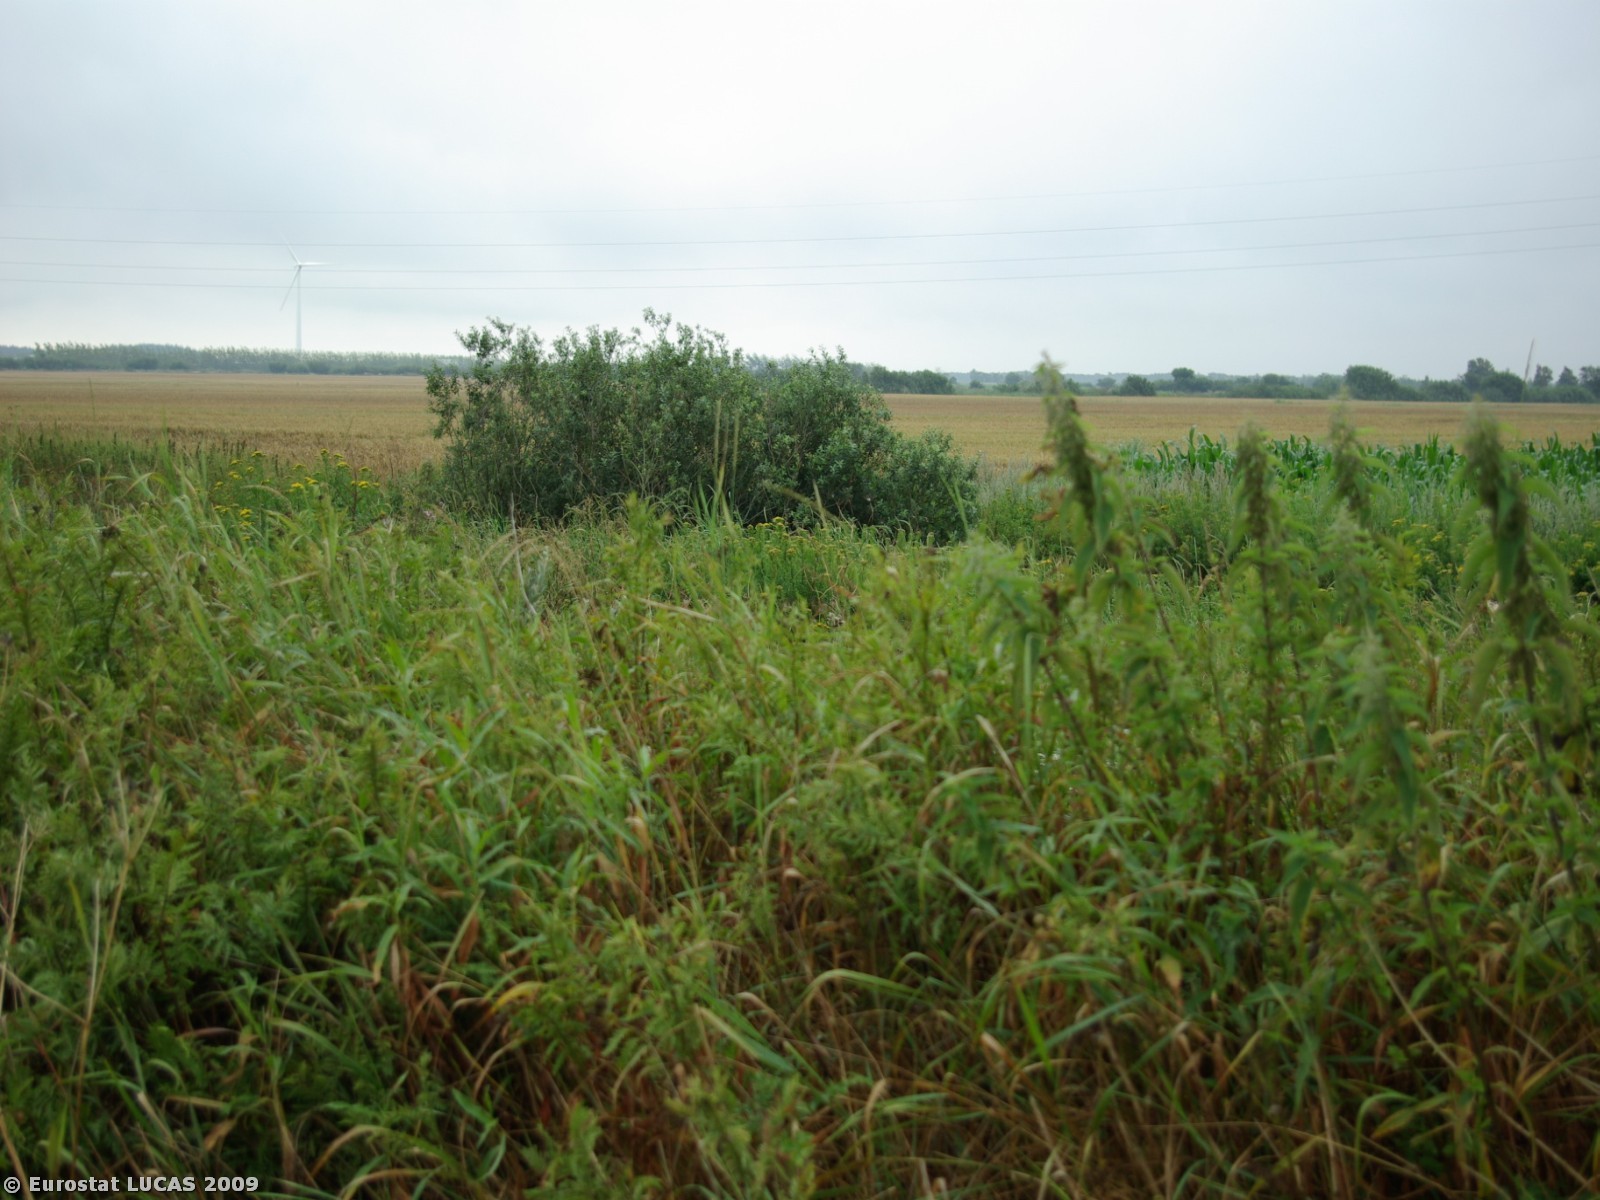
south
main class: Cropland
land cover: Rye
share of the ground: > 75 %
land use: Agriculture (excluding fallow land and kitchen gardens)
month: July
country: DK
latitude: 55.0669
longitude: 8.7326
